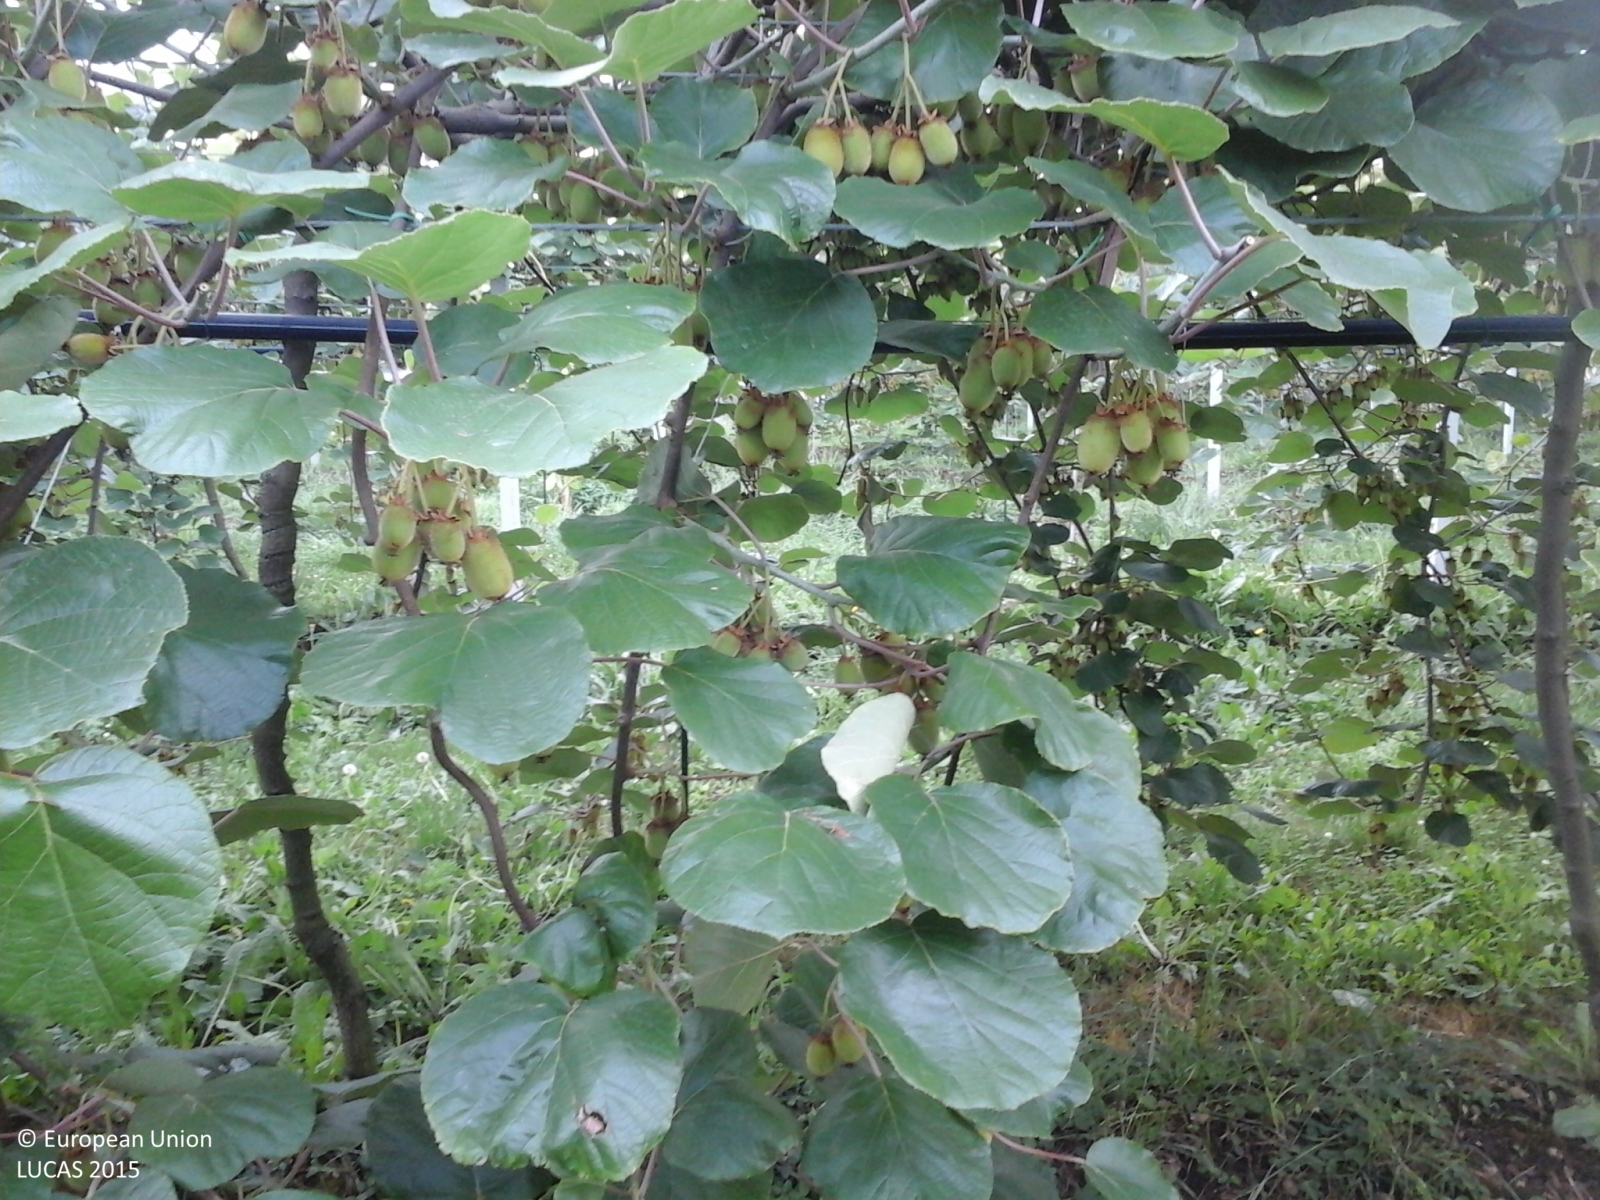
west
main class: Cropland
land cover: Other fruit trees and berries
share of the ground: 50 - 75 %
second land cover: Grassland without tree/shrub cover
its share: > 75 %
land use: Agriculture (excluding fallow land and kitchen gardens)
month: June
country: IT
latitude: 45.4284
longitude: 10.9059
